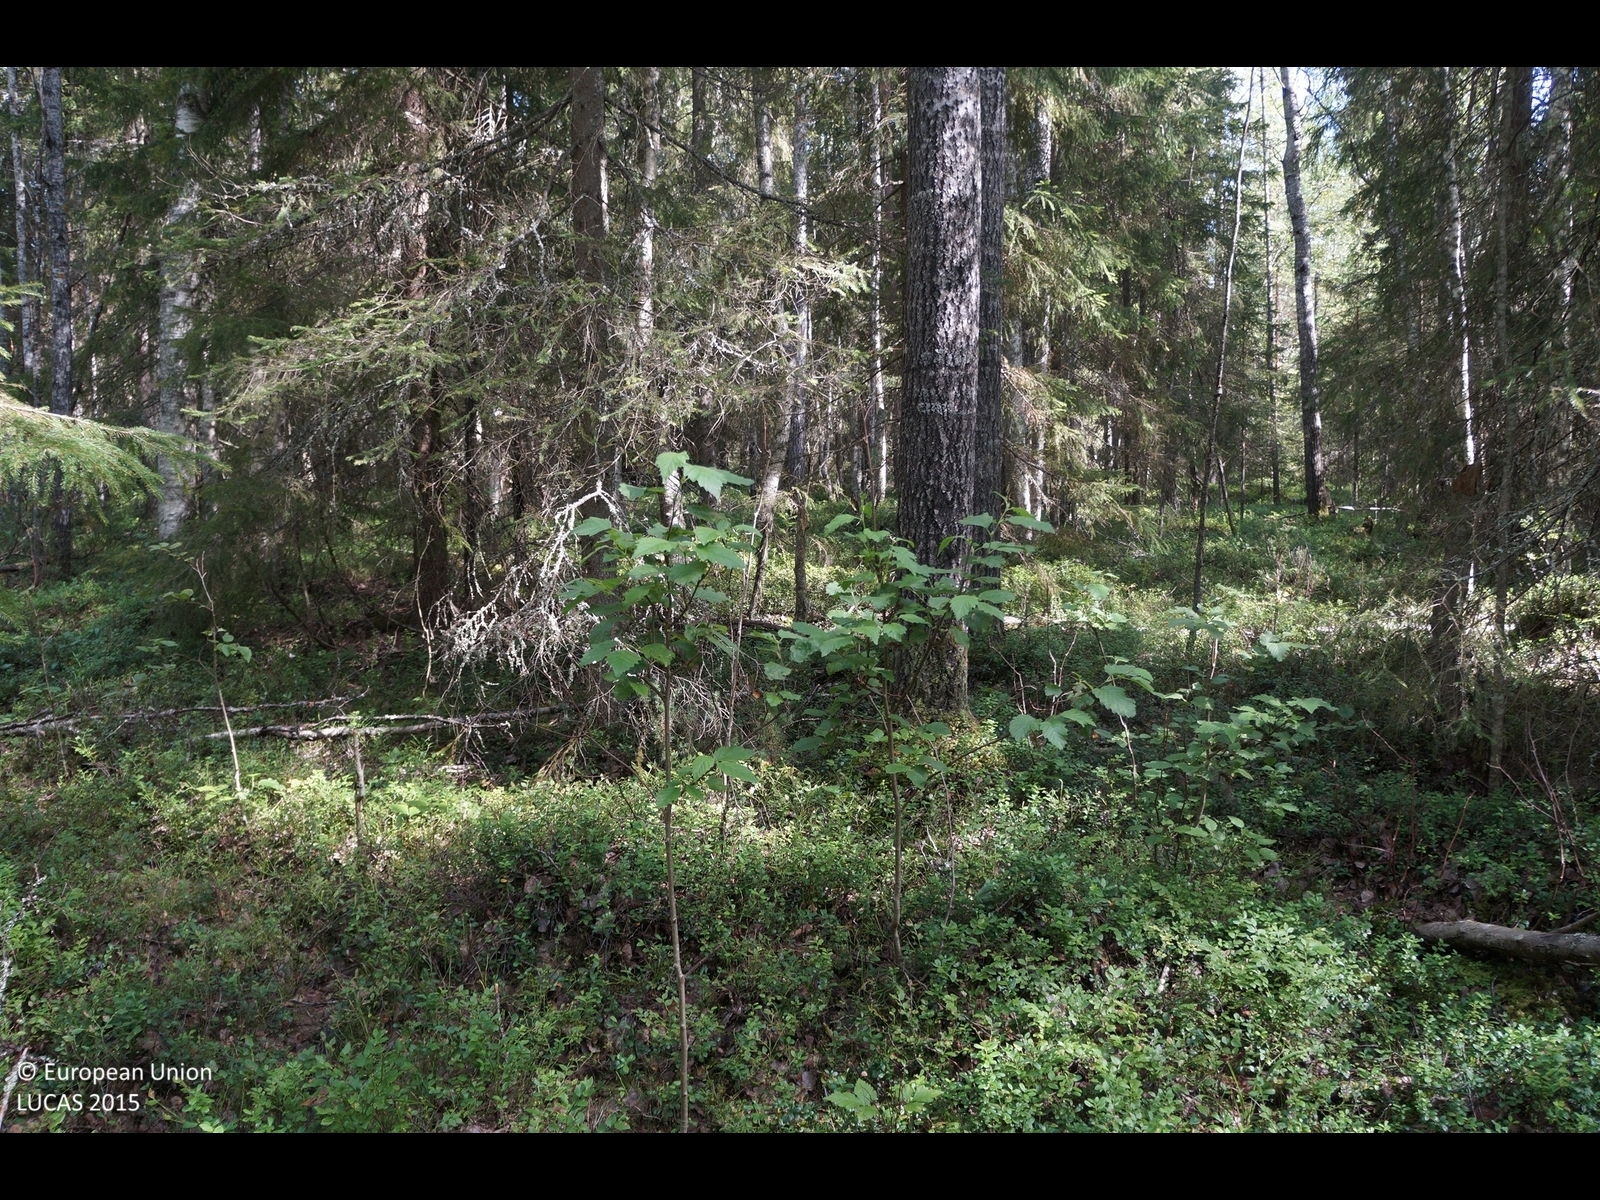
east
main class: Woodland
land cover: Spruce dominated mixed woodland
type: boreal forest
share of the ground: 50 - 75 %
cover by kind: coniferous forest trees 40 %, broadleaved forest trees 30 %, shrubs 25 %, lichens and mosses 5 %
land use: Forestry
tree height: > 5 m
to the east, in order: Spruce dominated mixed woodland; Pine dominated mixed woodland; Spruce dominated mixed woodland; Spruce dominated coniferous woodland
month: August
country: FI
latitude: 64.5885
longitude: 24.7560
